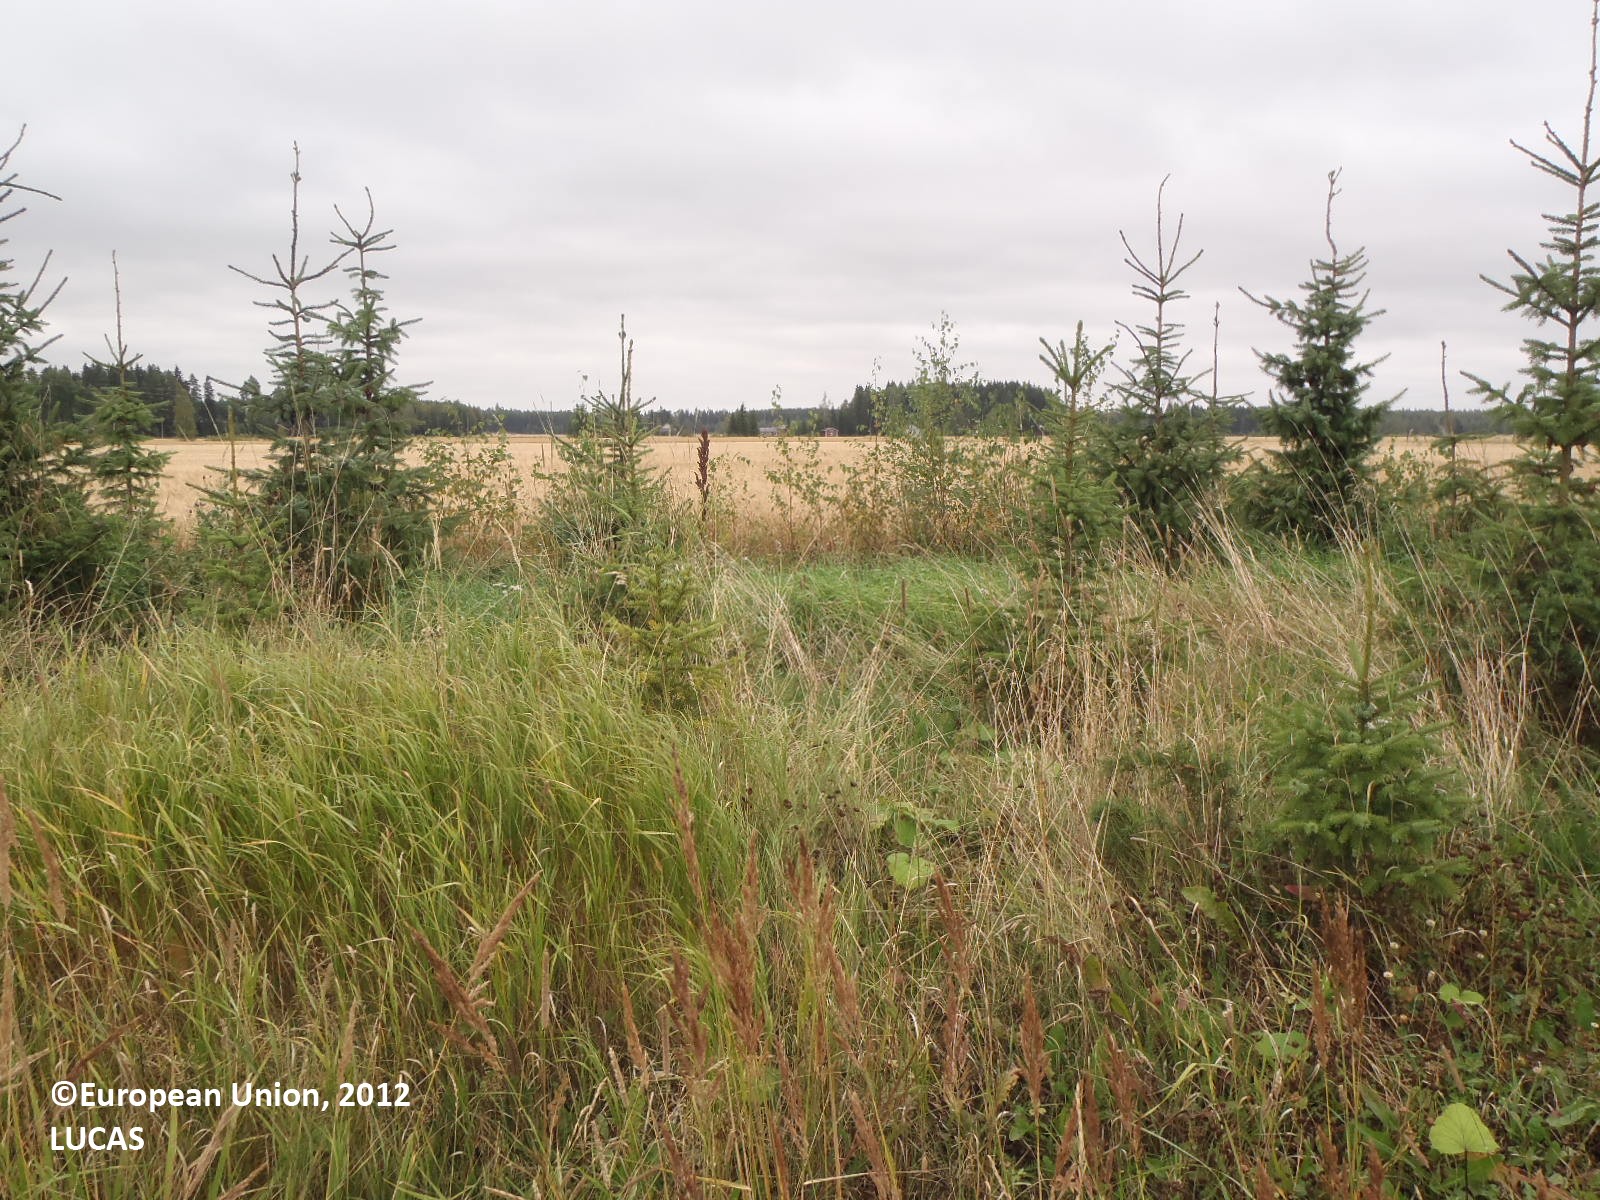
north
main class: Cropland
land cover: Barley
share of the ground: > 75 %
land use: Agriculture (excluding fallow land and kitchen gardens)
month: September
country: FI
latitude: 60.8001
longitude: 22.8072
